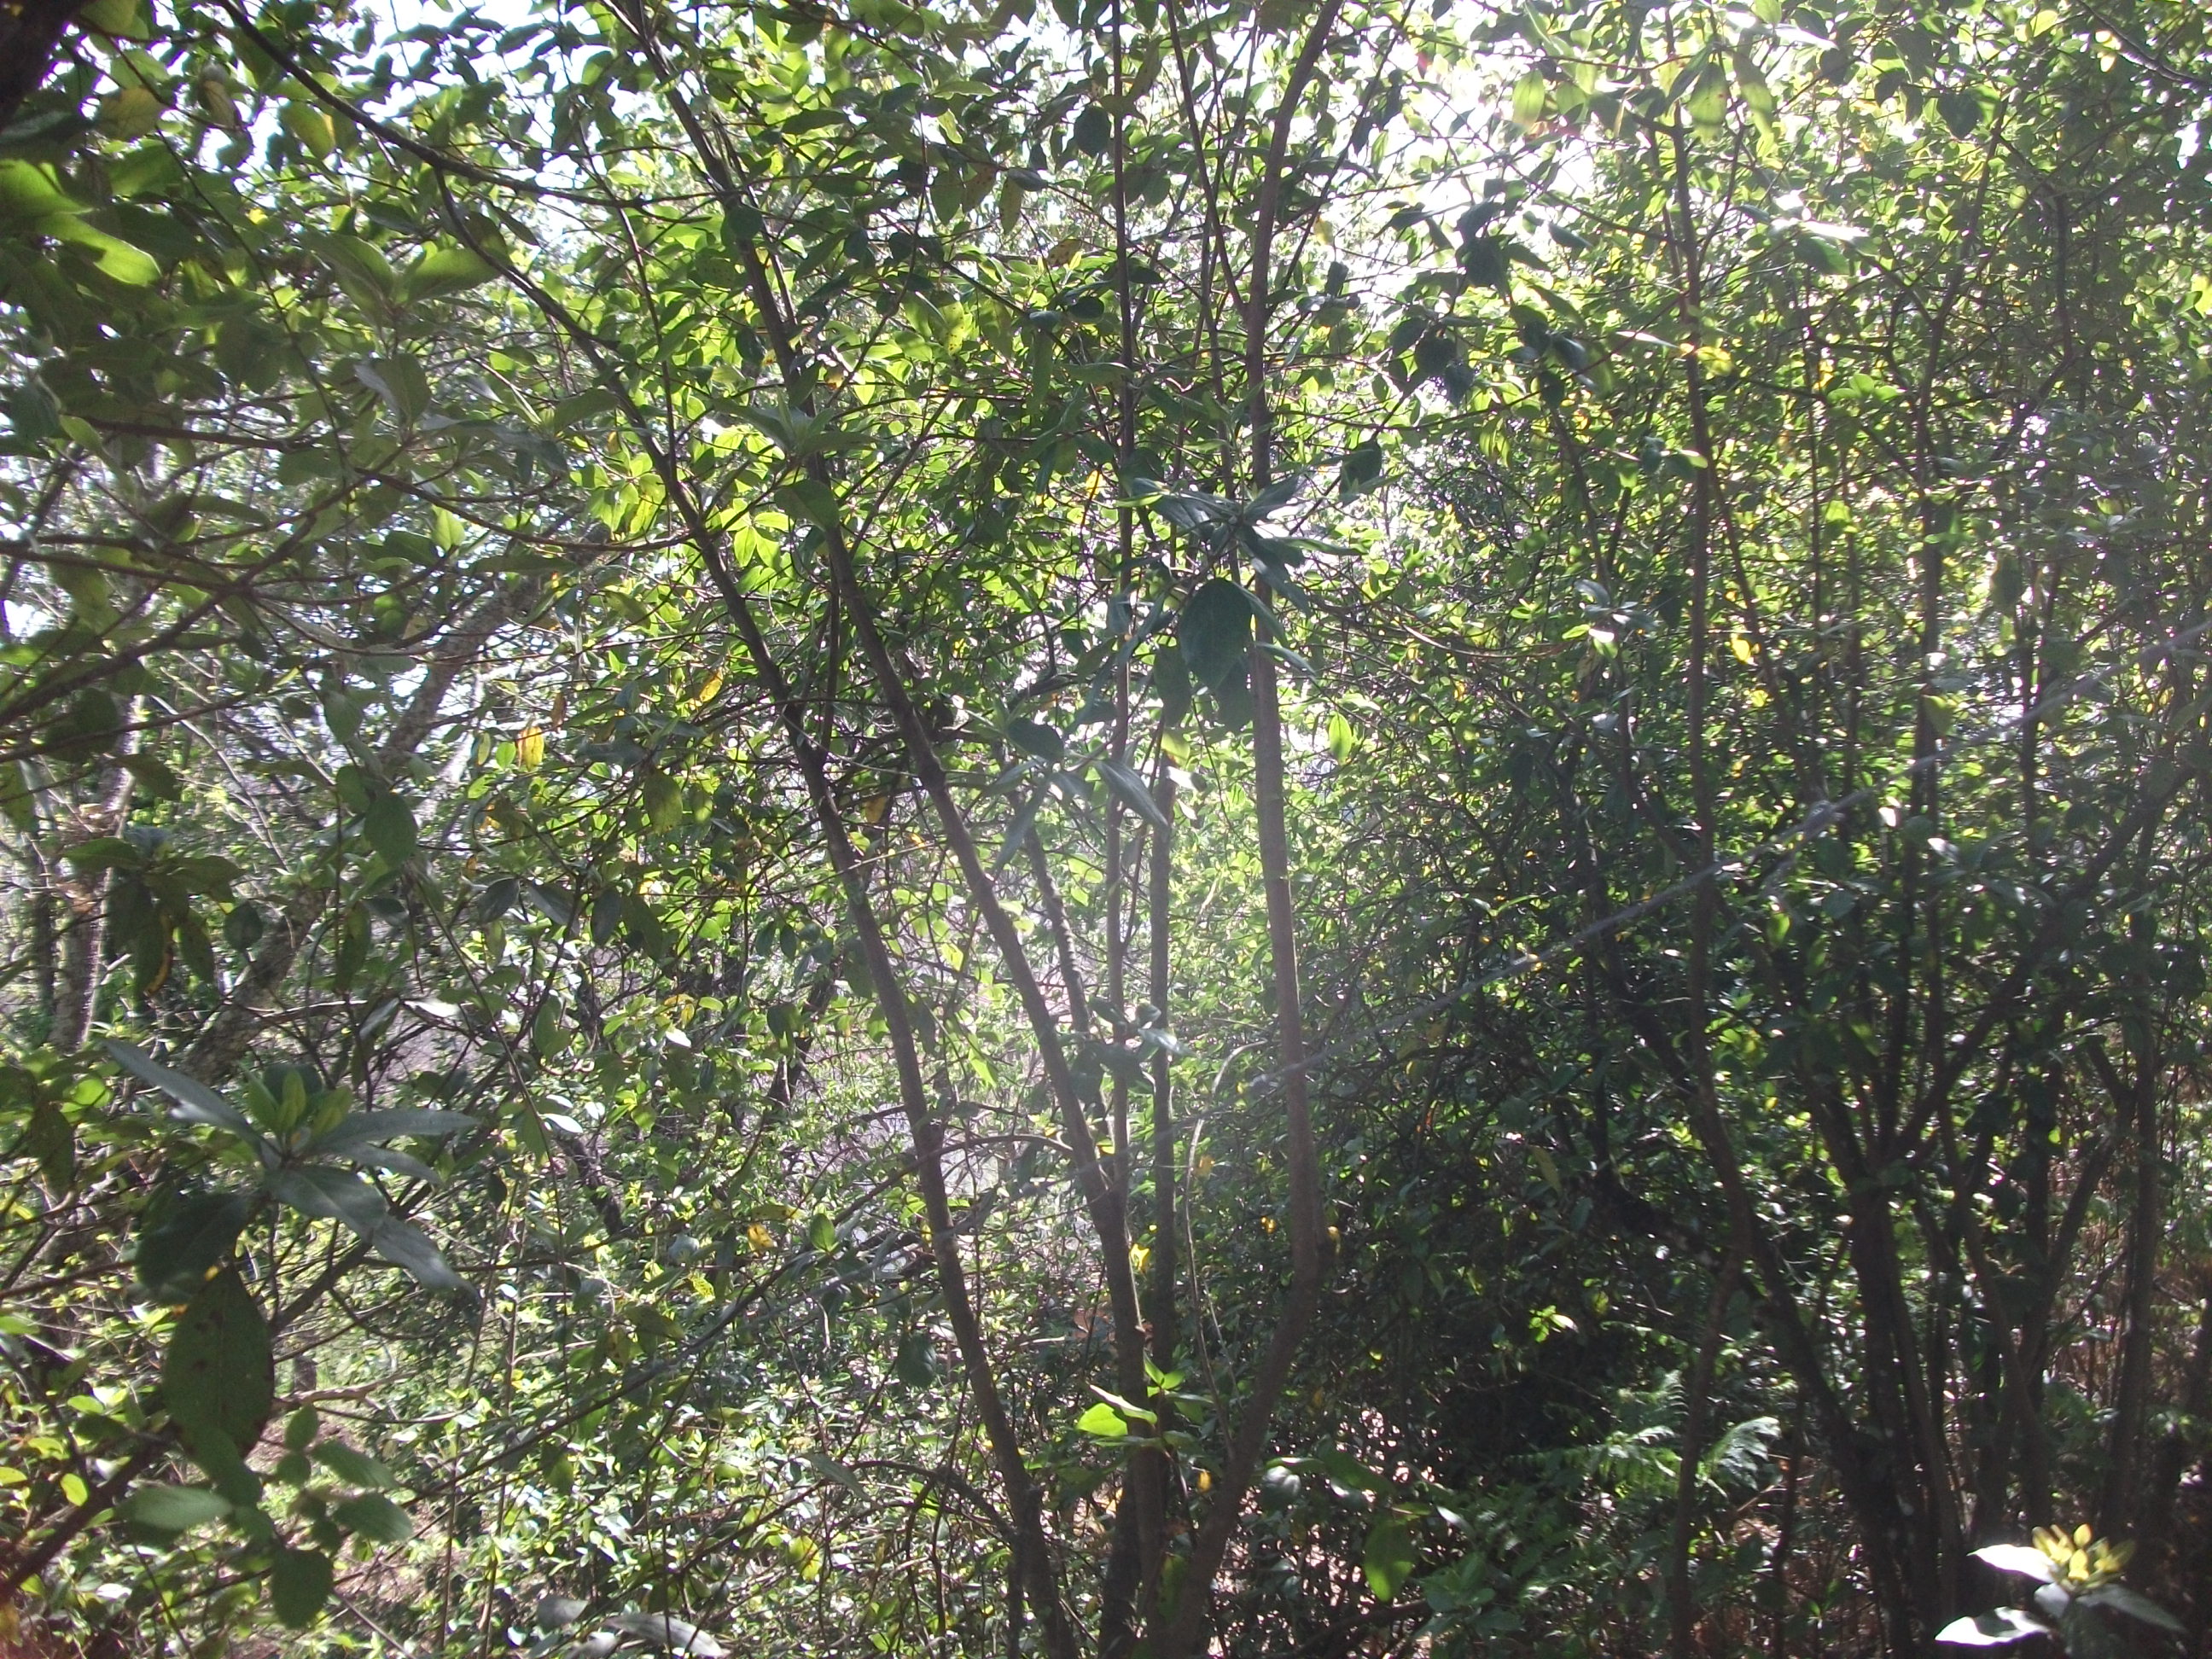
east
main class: Woodland
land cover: Broadleaved woodland
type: broadleaved evergreen forest
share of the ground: > 75 %
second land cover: Spontaneously vegetated surfaces
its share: < 10 %
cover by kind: broadleaved forest trees 95 %, herbaceous plants 5 %
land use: Forestry
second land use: Agriculture (excluding fallow land and kitchen gardens)
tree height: > 5 m
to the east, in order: Broadleaved woodland; Spontaneously vegetated surfaces; Fences; Broadleaved woodland; Fences; Dry stone walls; Artificial constructions in urban areas
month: April
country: ES
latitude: 37.9149
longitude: -6.7339
